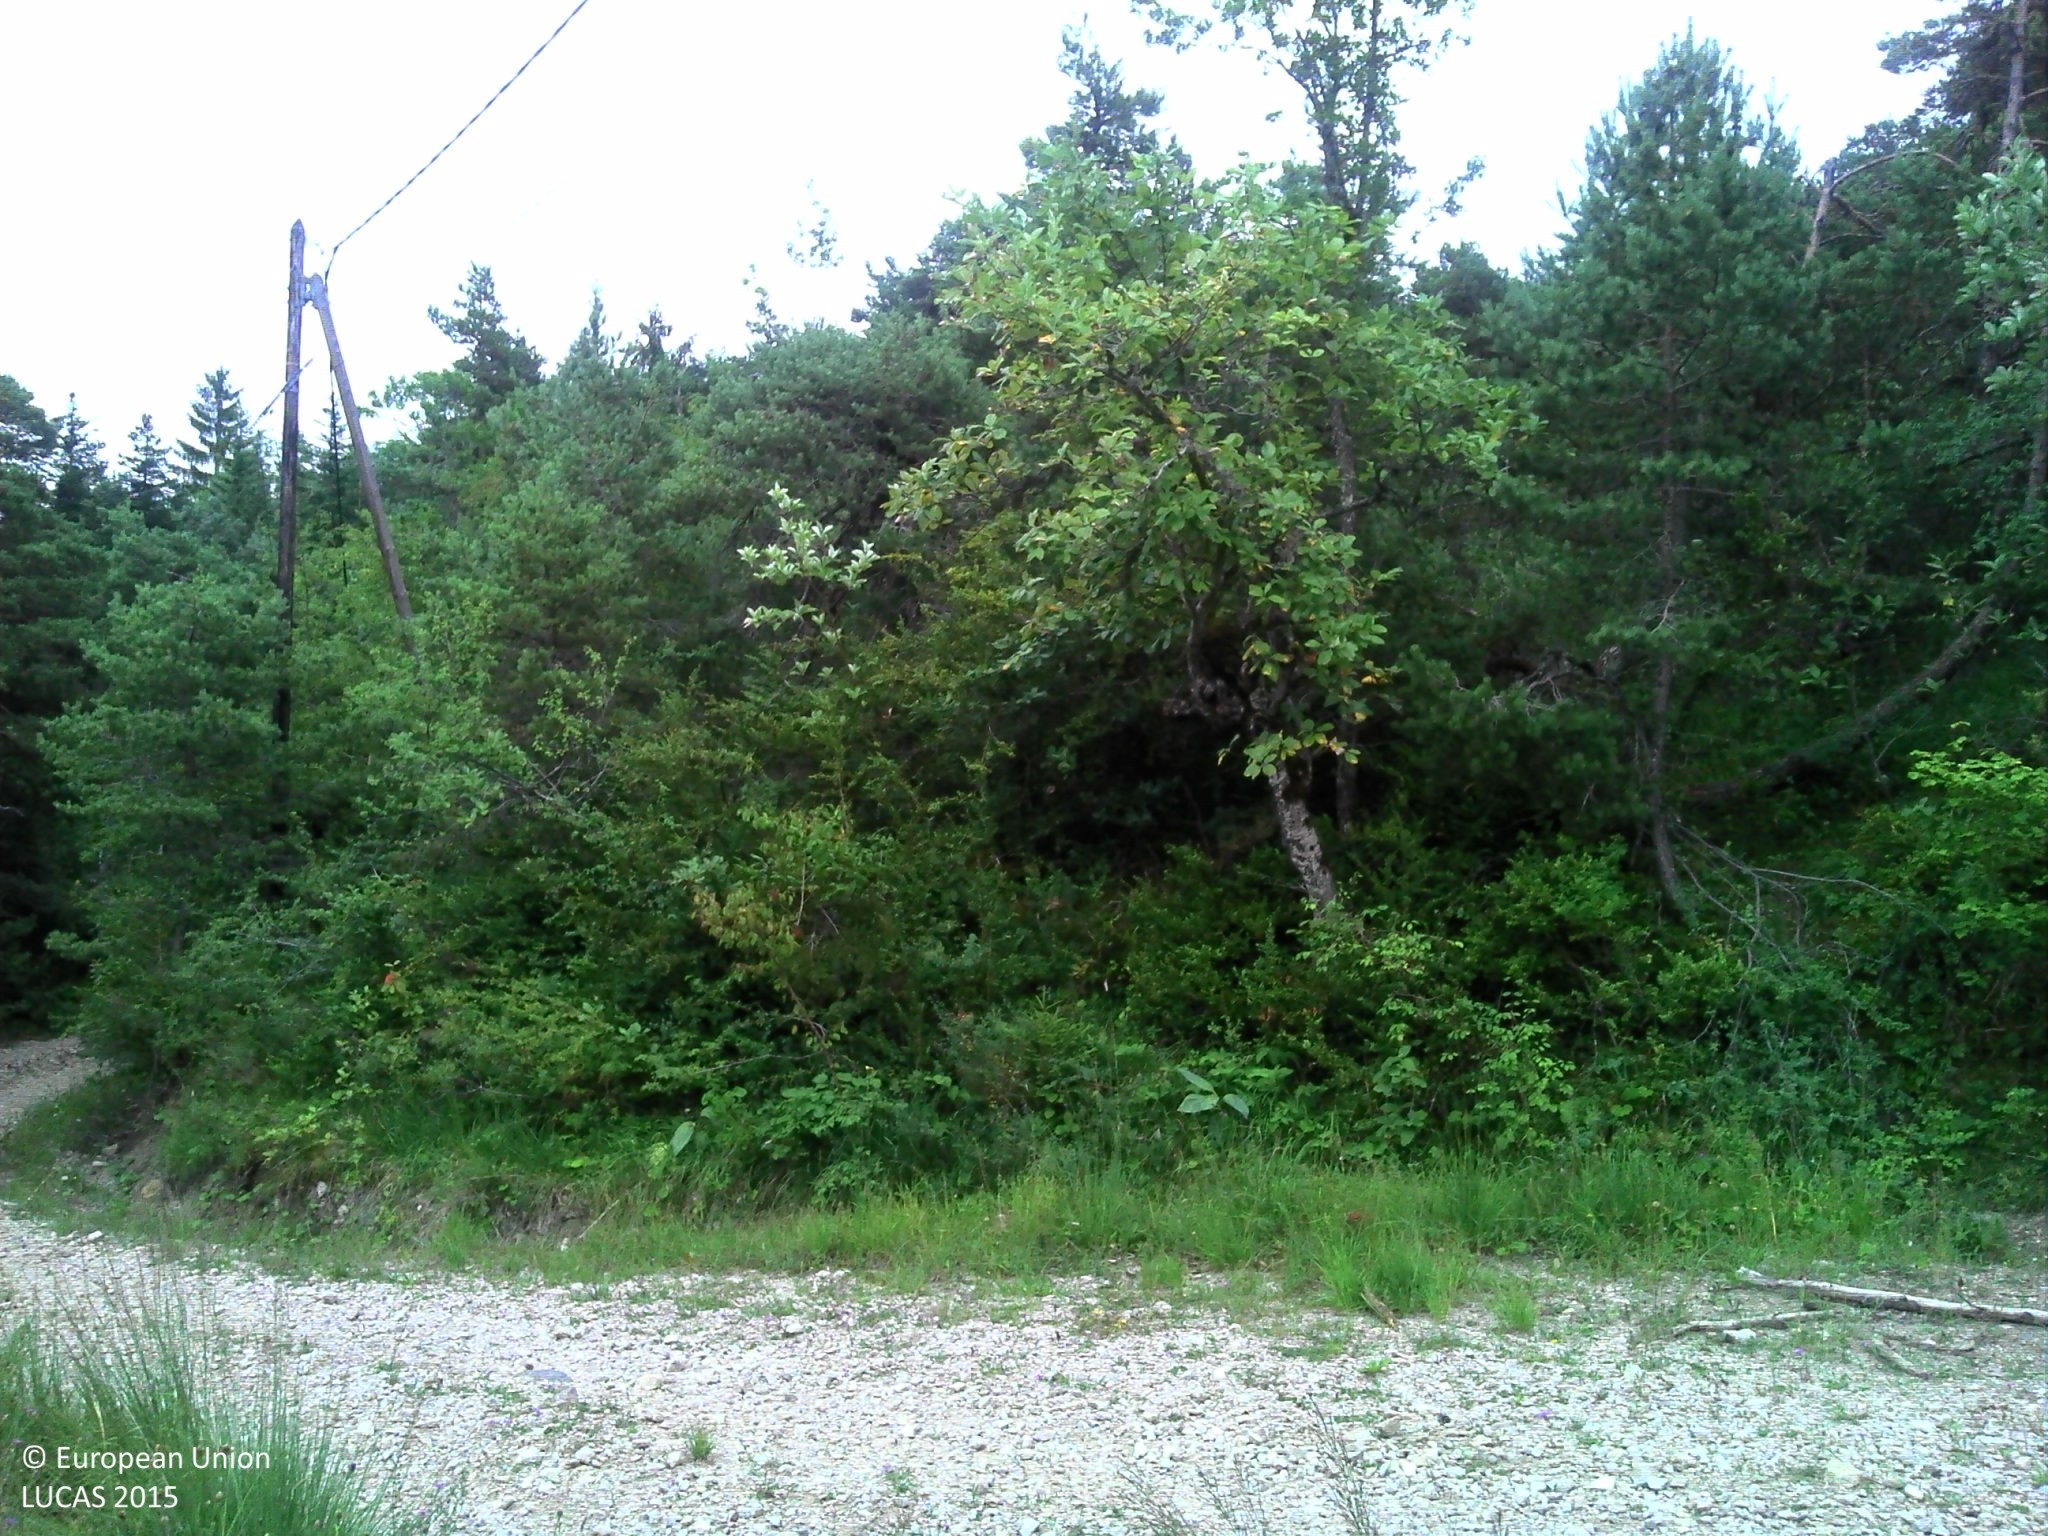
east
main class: Woodland
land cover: Other mixed woodland
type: alpine coniferous forest
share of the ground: > 75 %
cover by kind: coniferous forest trees 75 %, broadleaved forest trees 25 %
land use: Semi-natural and natural areas not in use
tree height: > 5 m
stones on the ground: 10 - 25 %
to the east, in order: Other mixed woodland; Grassland with sparse tree/shrub cover; Other mixed woodland; Tracks; Other mixed woodland
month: July
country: FR
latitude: 44.7818
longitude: 5.6209
